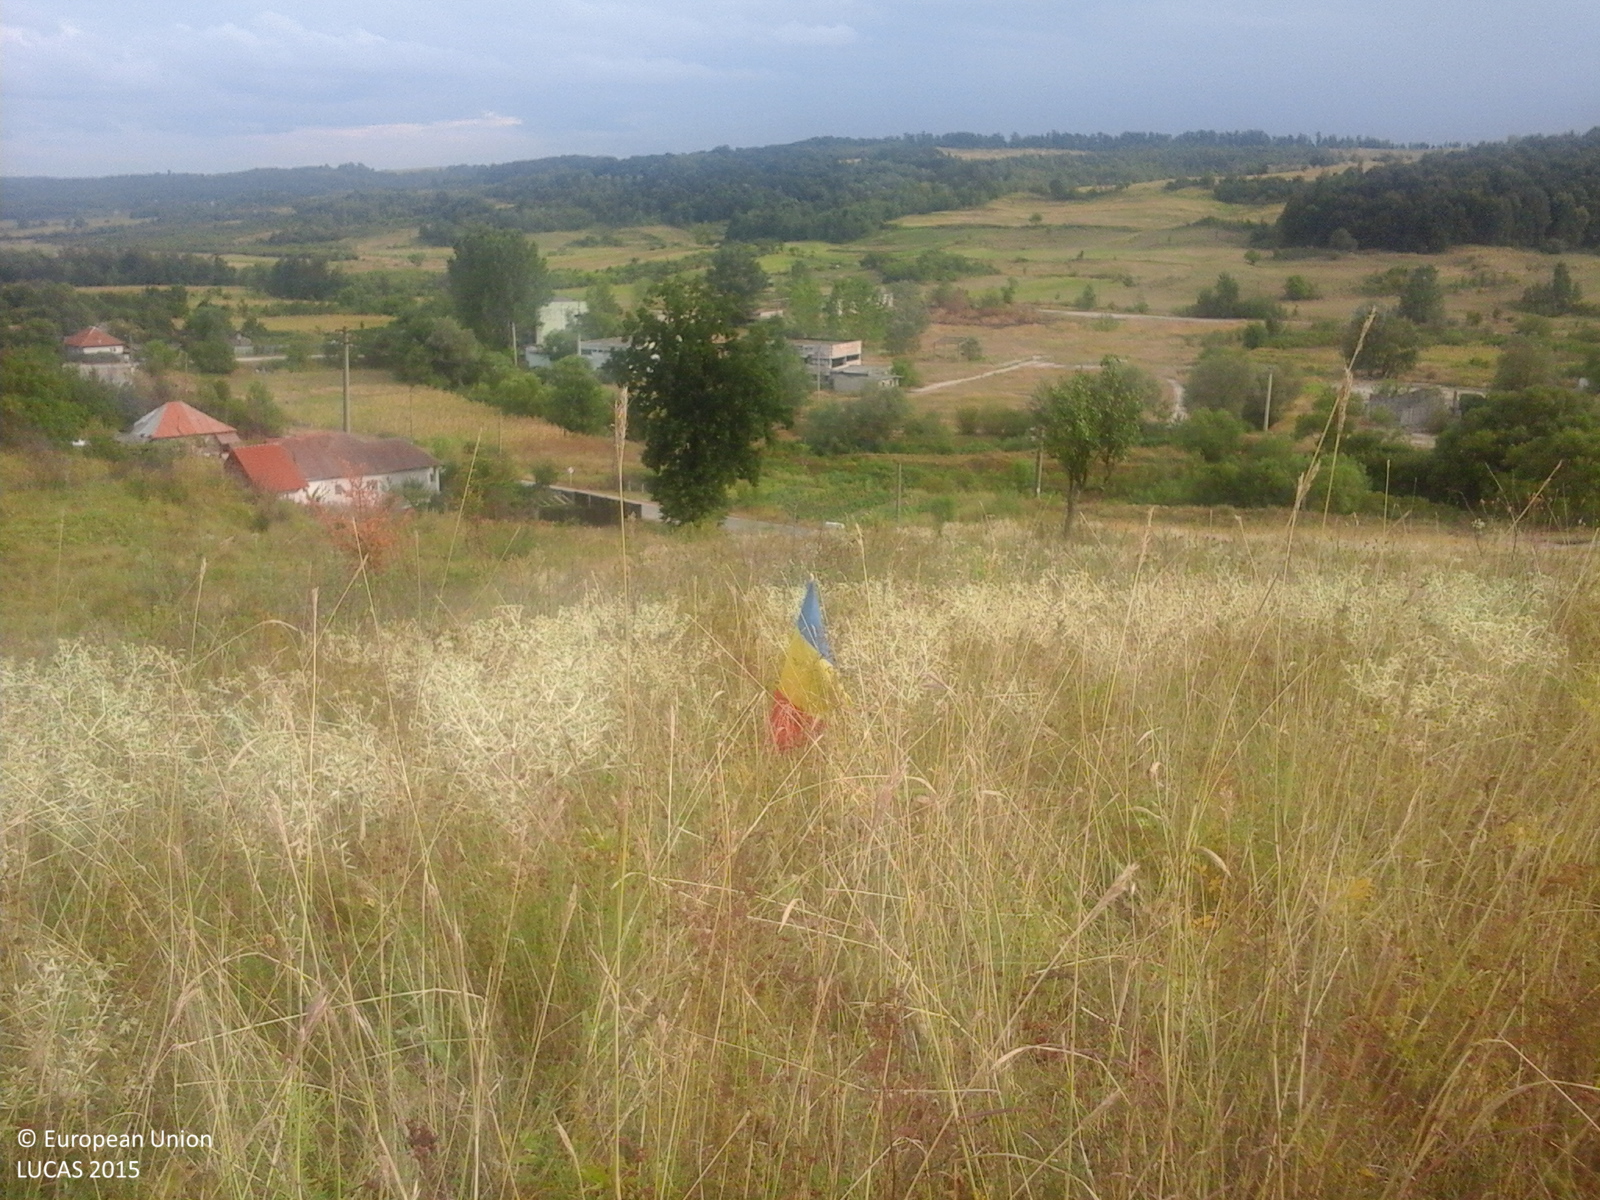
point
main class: Grassland
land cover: Spontaneously vegetated surfaces
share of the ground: > 75 %
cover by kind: herbaceous plants 100 %
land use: Fallow land
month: August
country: RO
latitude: 44.8000
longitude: 22.9032
